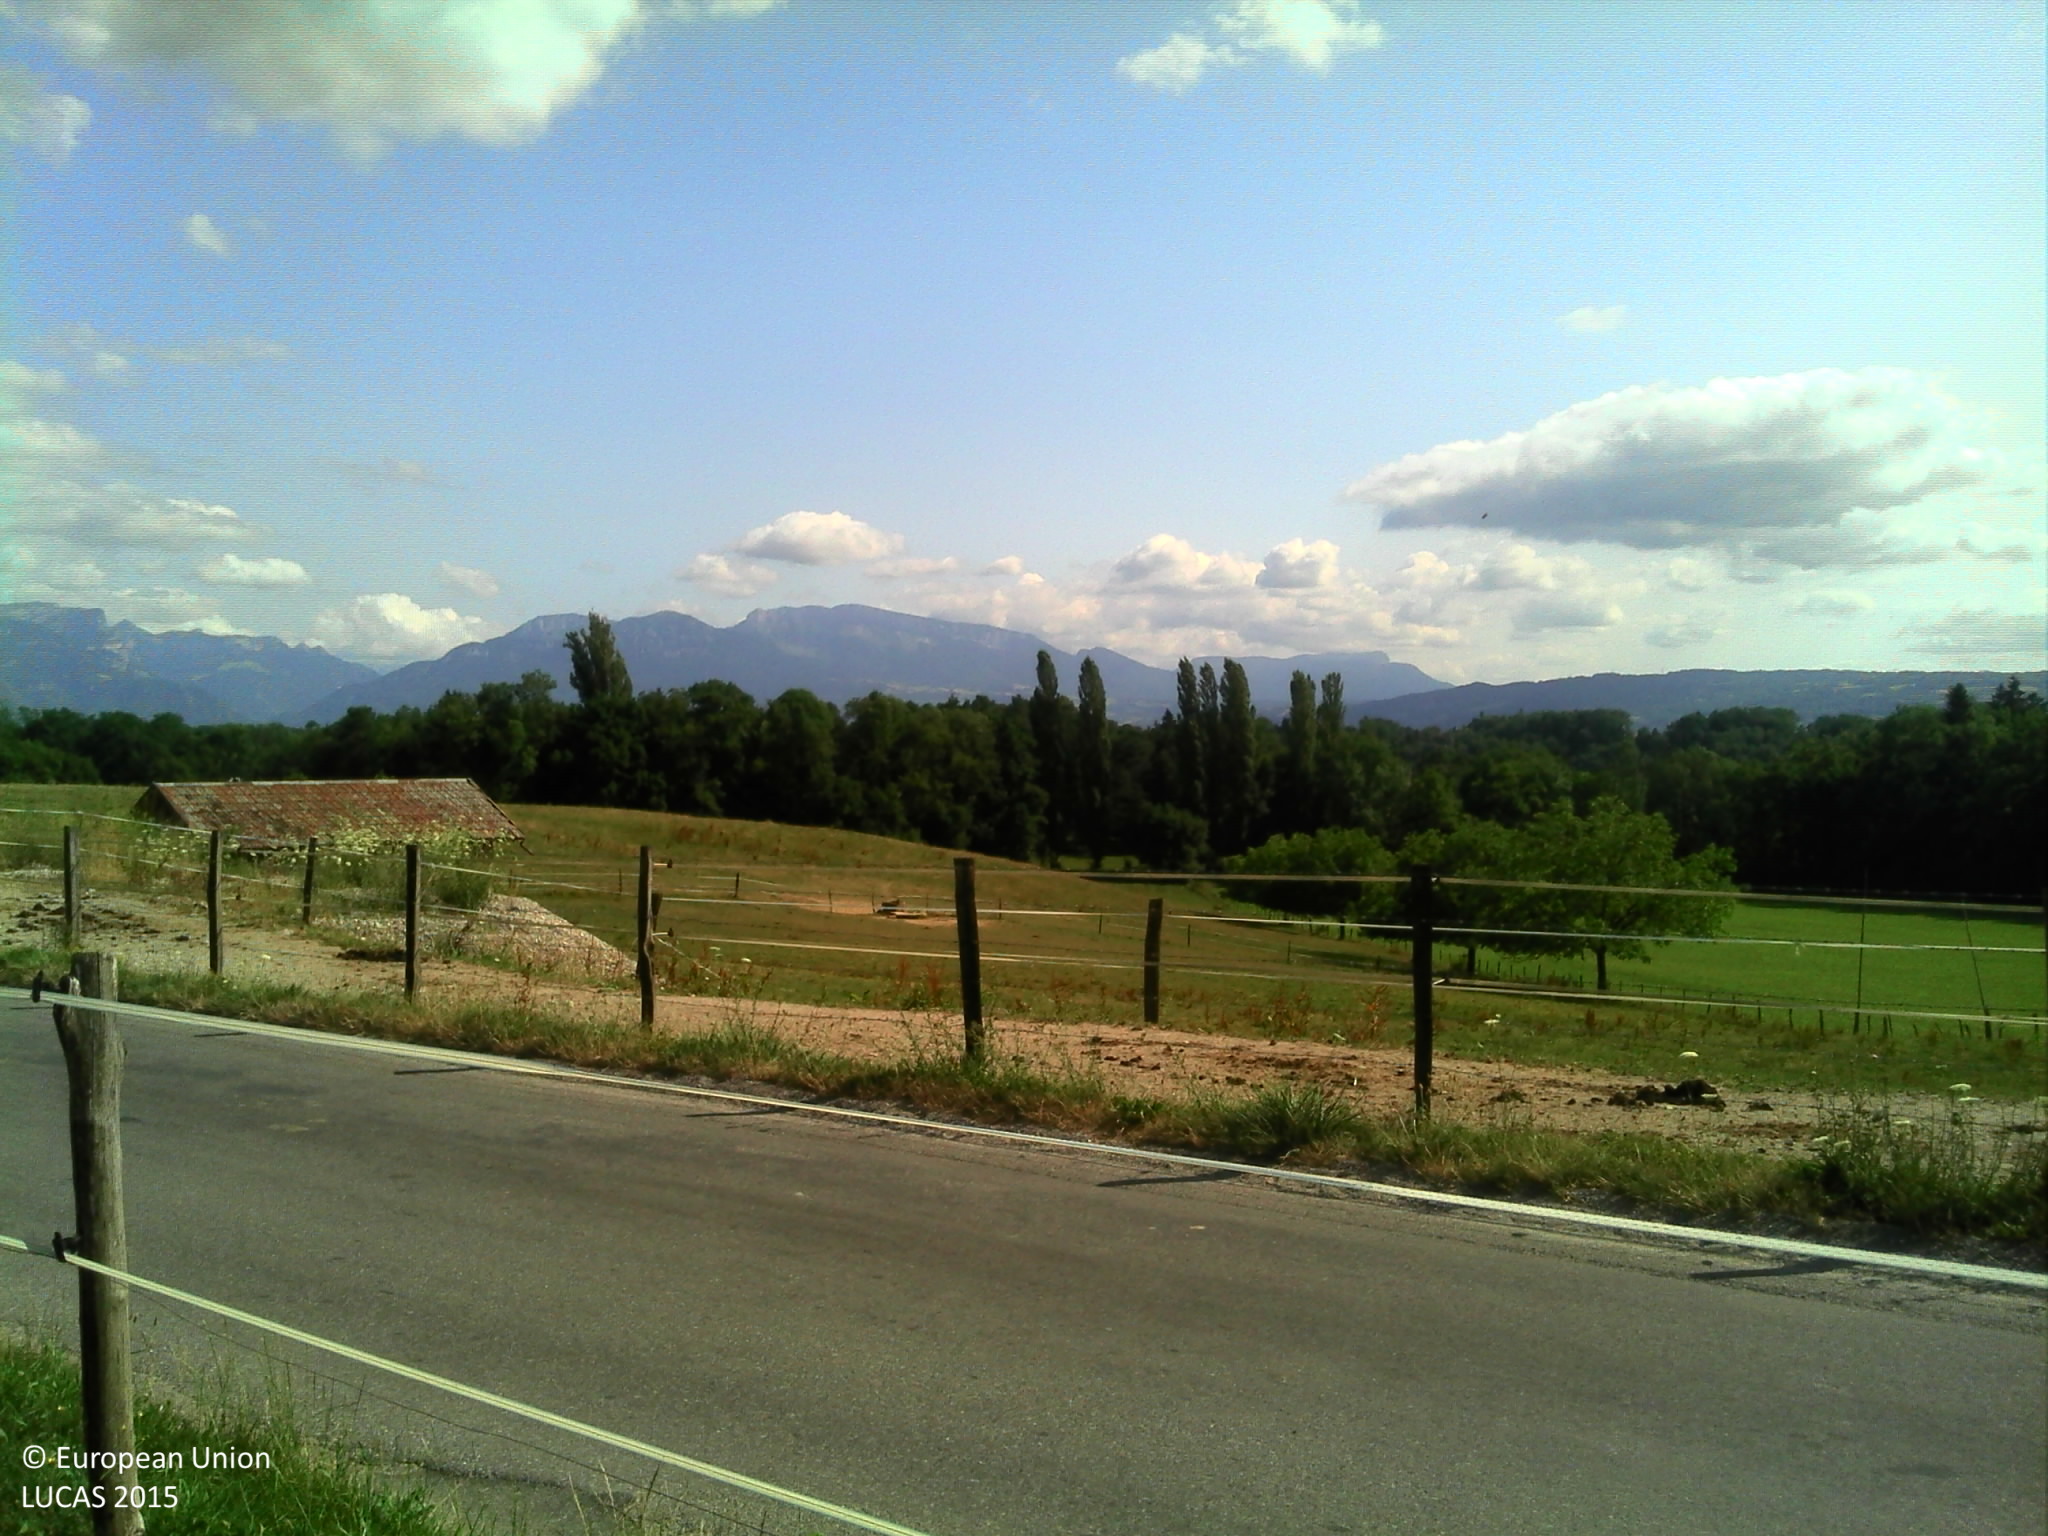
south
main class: Grassland
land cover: Grassland without tree/shrub cover
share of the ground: > 75 %
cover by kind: herbaceous plants 100 %
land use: Agriculture (excluding fallow land and kitchen gardens)
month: July
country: FR
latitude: 46.1795
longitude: 6.3115
